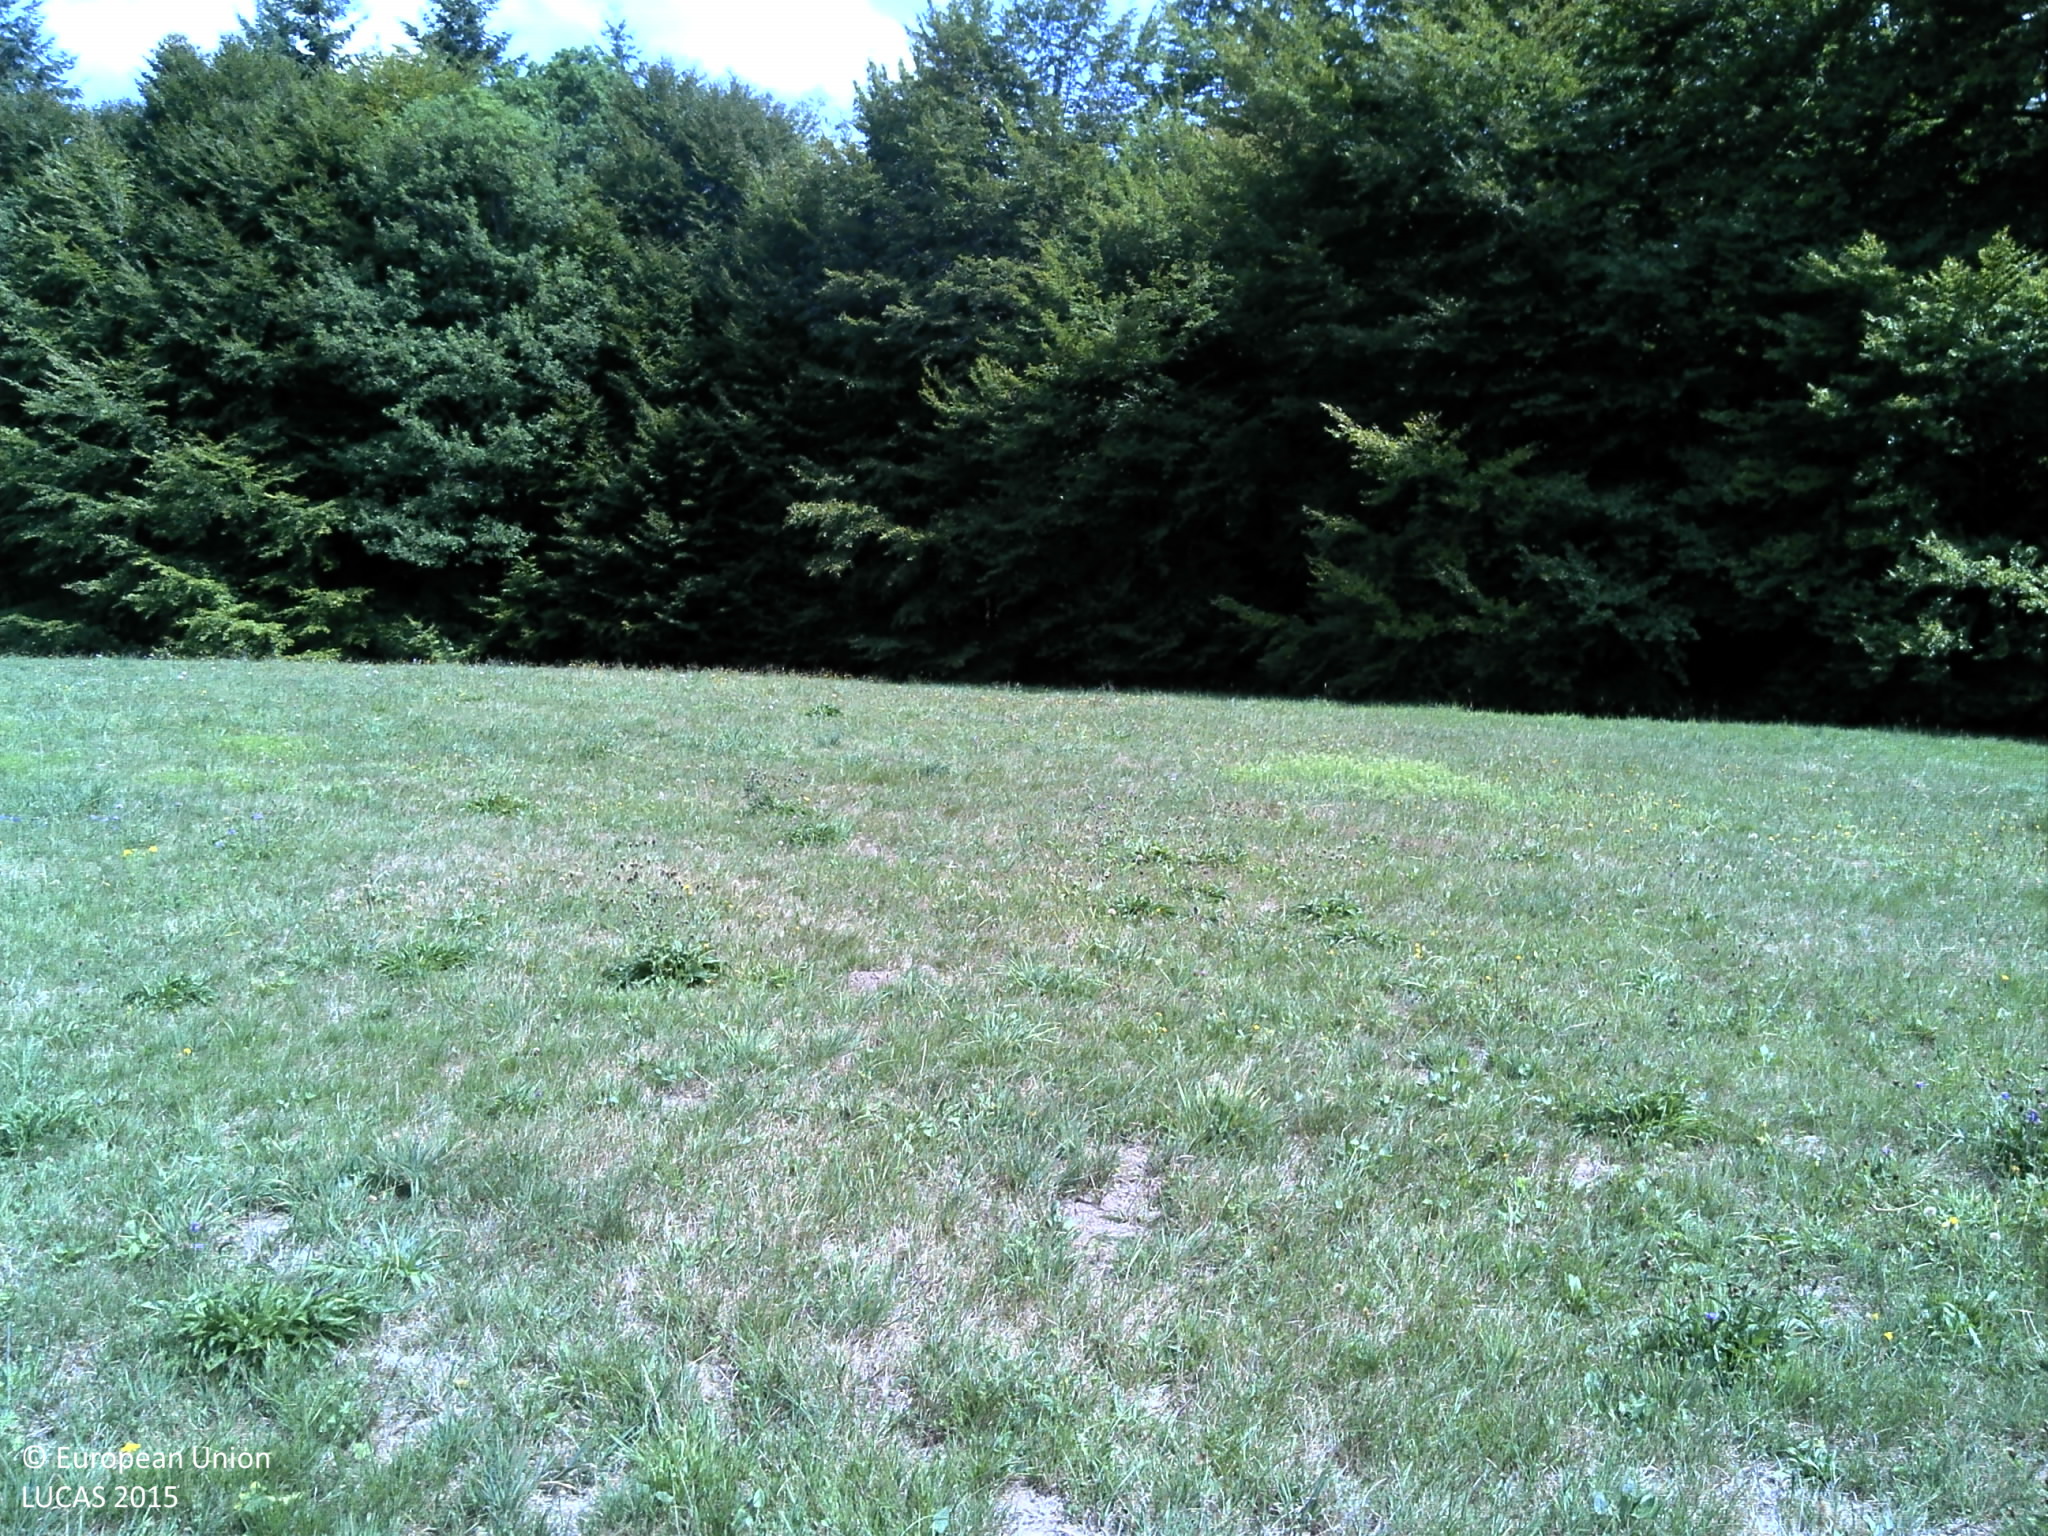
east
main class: Grassland
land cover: Grassland without tree/shrub cover
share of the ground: > 75 %
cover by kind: herbaceous plants 100 %
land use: Agriculture (excluding fallow land and kitchen gardens)
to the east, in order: Grassland without tree/shrub cover; Broadleaved woodland; Spruce dominated coniferous woodland; Spruce dominated mixed woodland; Tracks; Spruce dominated mixed woodland; Spontaneously vegetated surfaces; Fences; Grassland with sparse tree/shrub cover; Grassland without tree/shrub cover
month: August
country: FR
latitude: 48.0008
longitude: 6.3419
